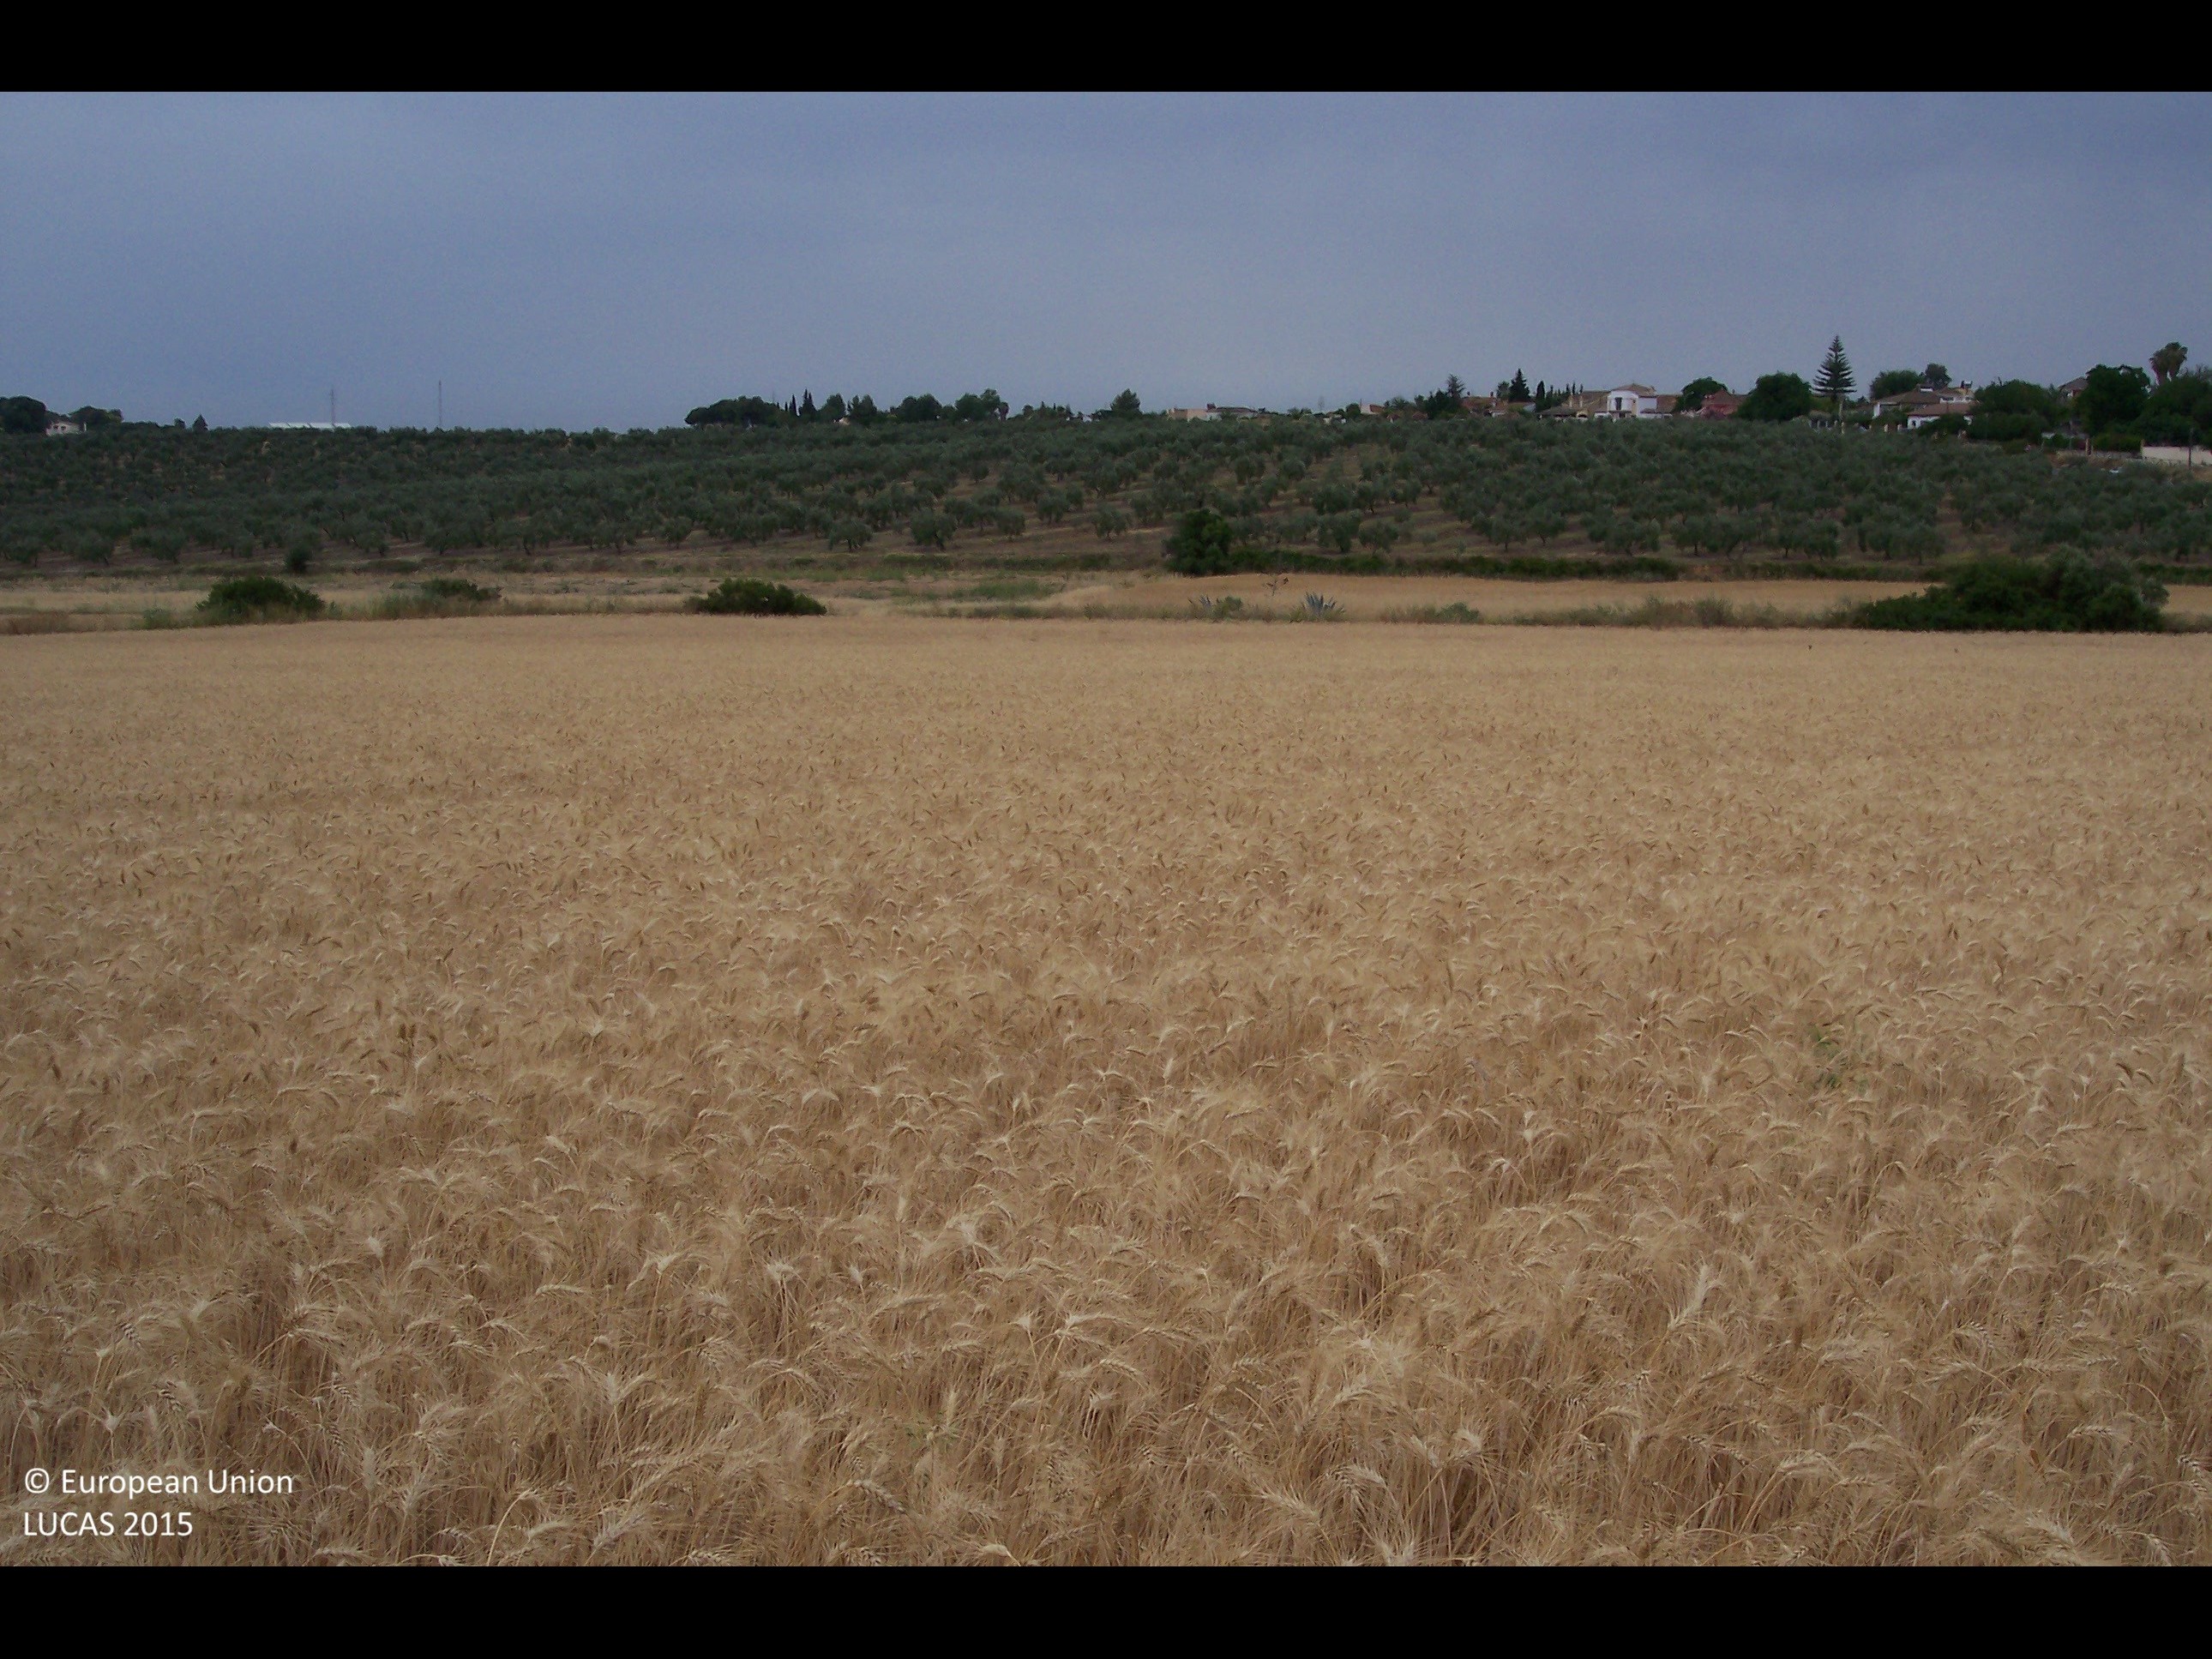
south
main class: Cropland
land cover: Durum wheat
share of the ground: > 75 %
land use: Agriculture (excluding fallow land and kitchen gardens)
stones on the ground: < 10 %
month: June
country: ES
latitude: 37.3139
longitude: -6.0573
